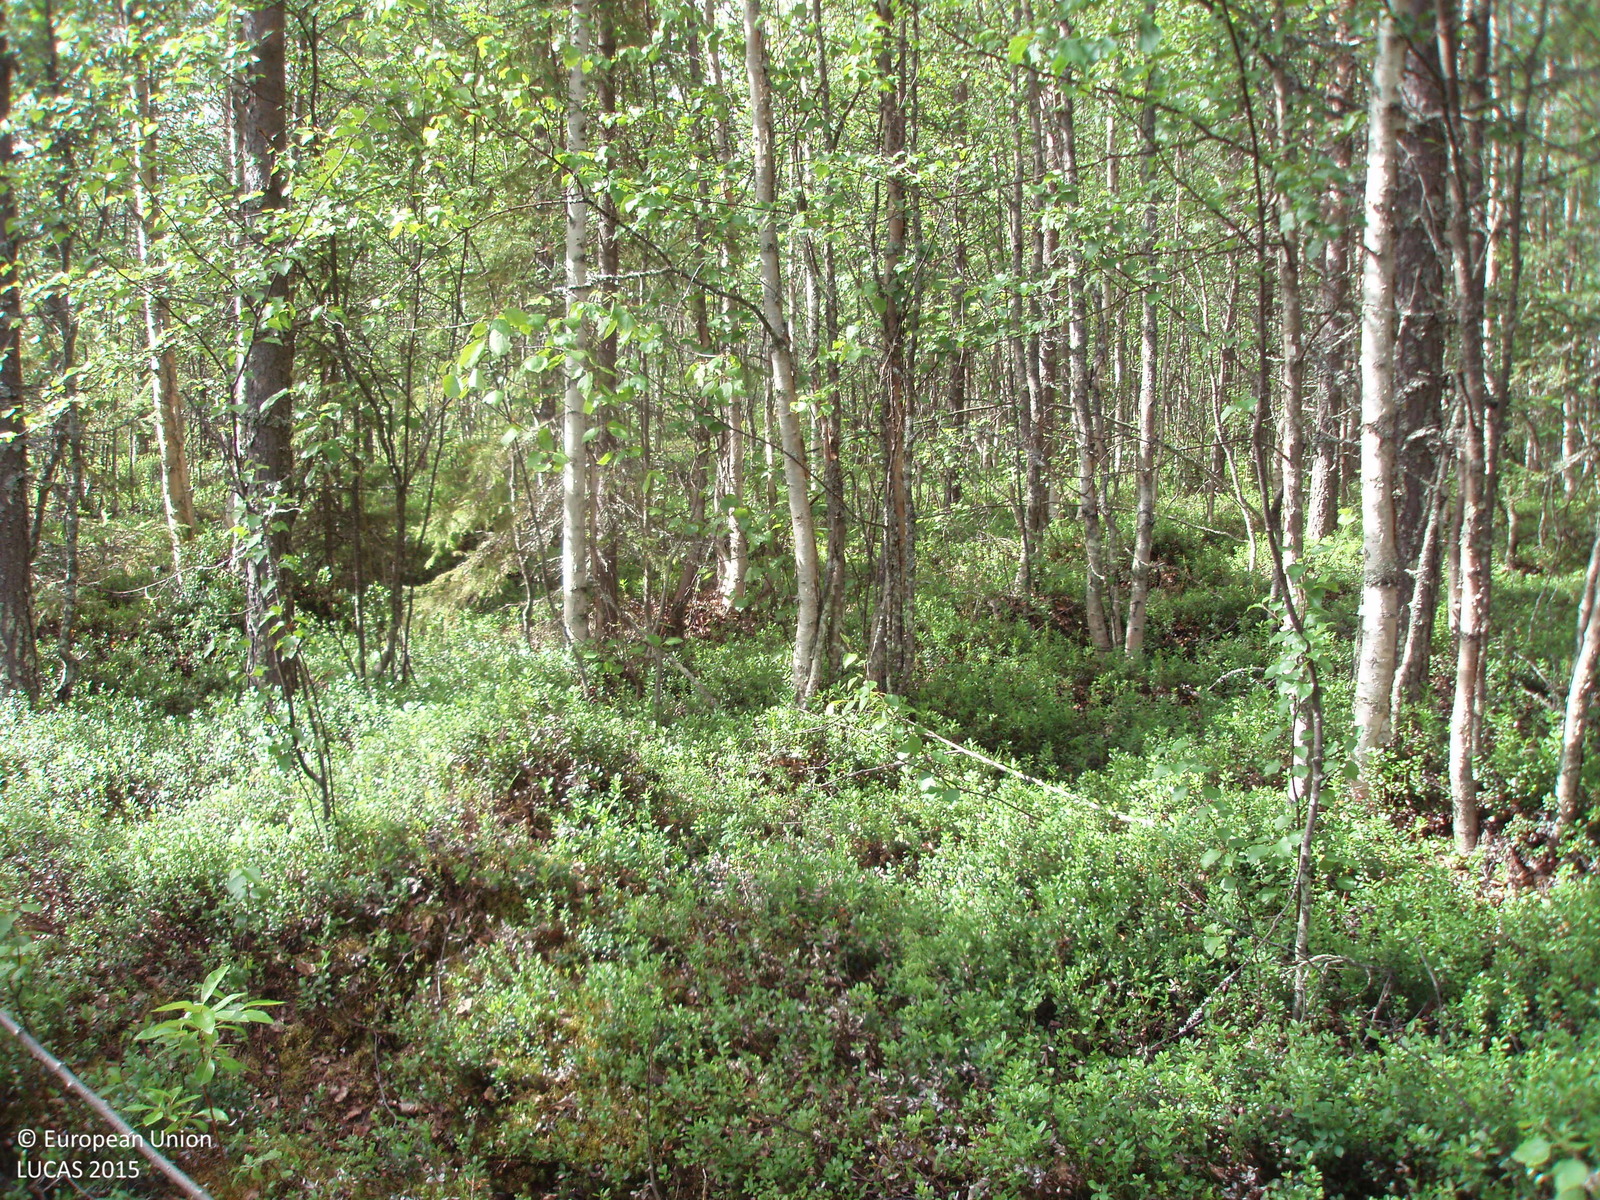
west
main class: Woodland
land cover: Pine dominated mixed woodland
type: boreal forest
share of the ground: > 75 %
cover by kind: coniferous forest trees 40 %, broadleaved forest trees 35 %, shrubs 25 %
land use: Forestry
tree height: > 5 m
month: July
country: FI
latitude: 66.9890
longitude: 28.0734
